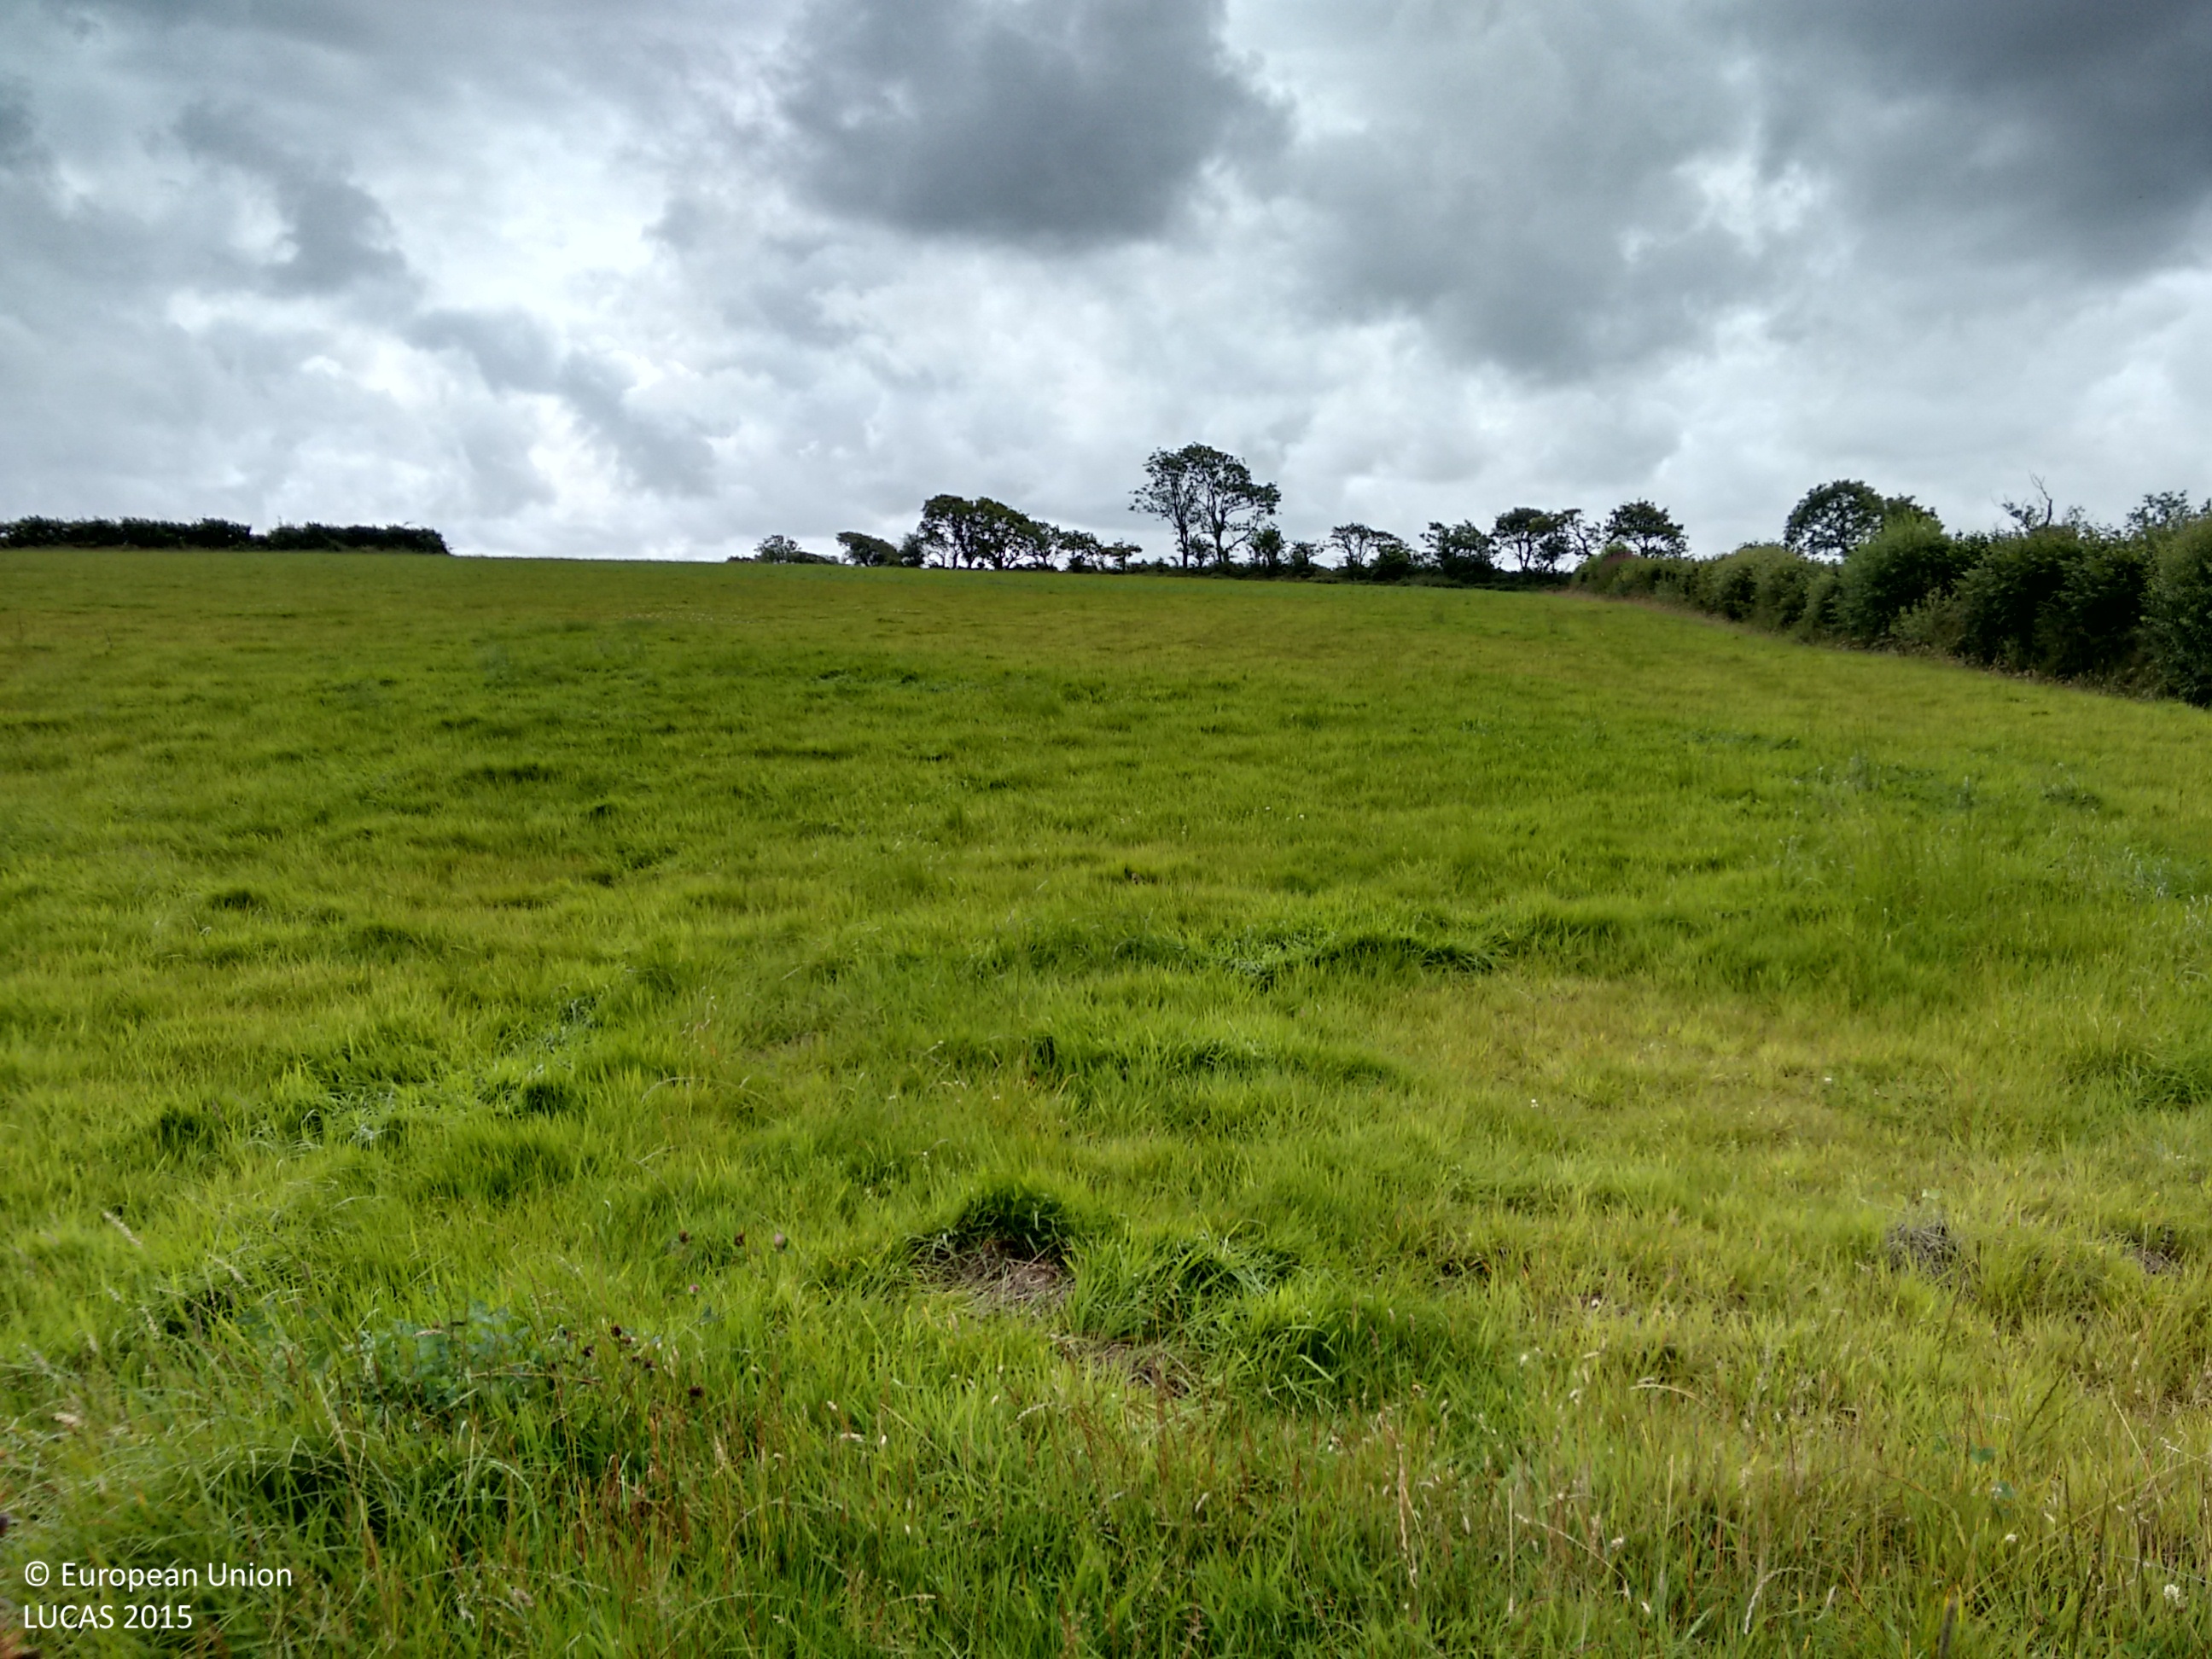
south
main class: Grassland
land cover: Grassland without tree/shrub cover
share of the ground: > 75 %
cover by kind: herbaceous plants 100 %
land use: Agriculture (excluding fallow land and kitchen gardens)
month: August
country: GB
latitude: 51.8403
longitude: -4.1029
